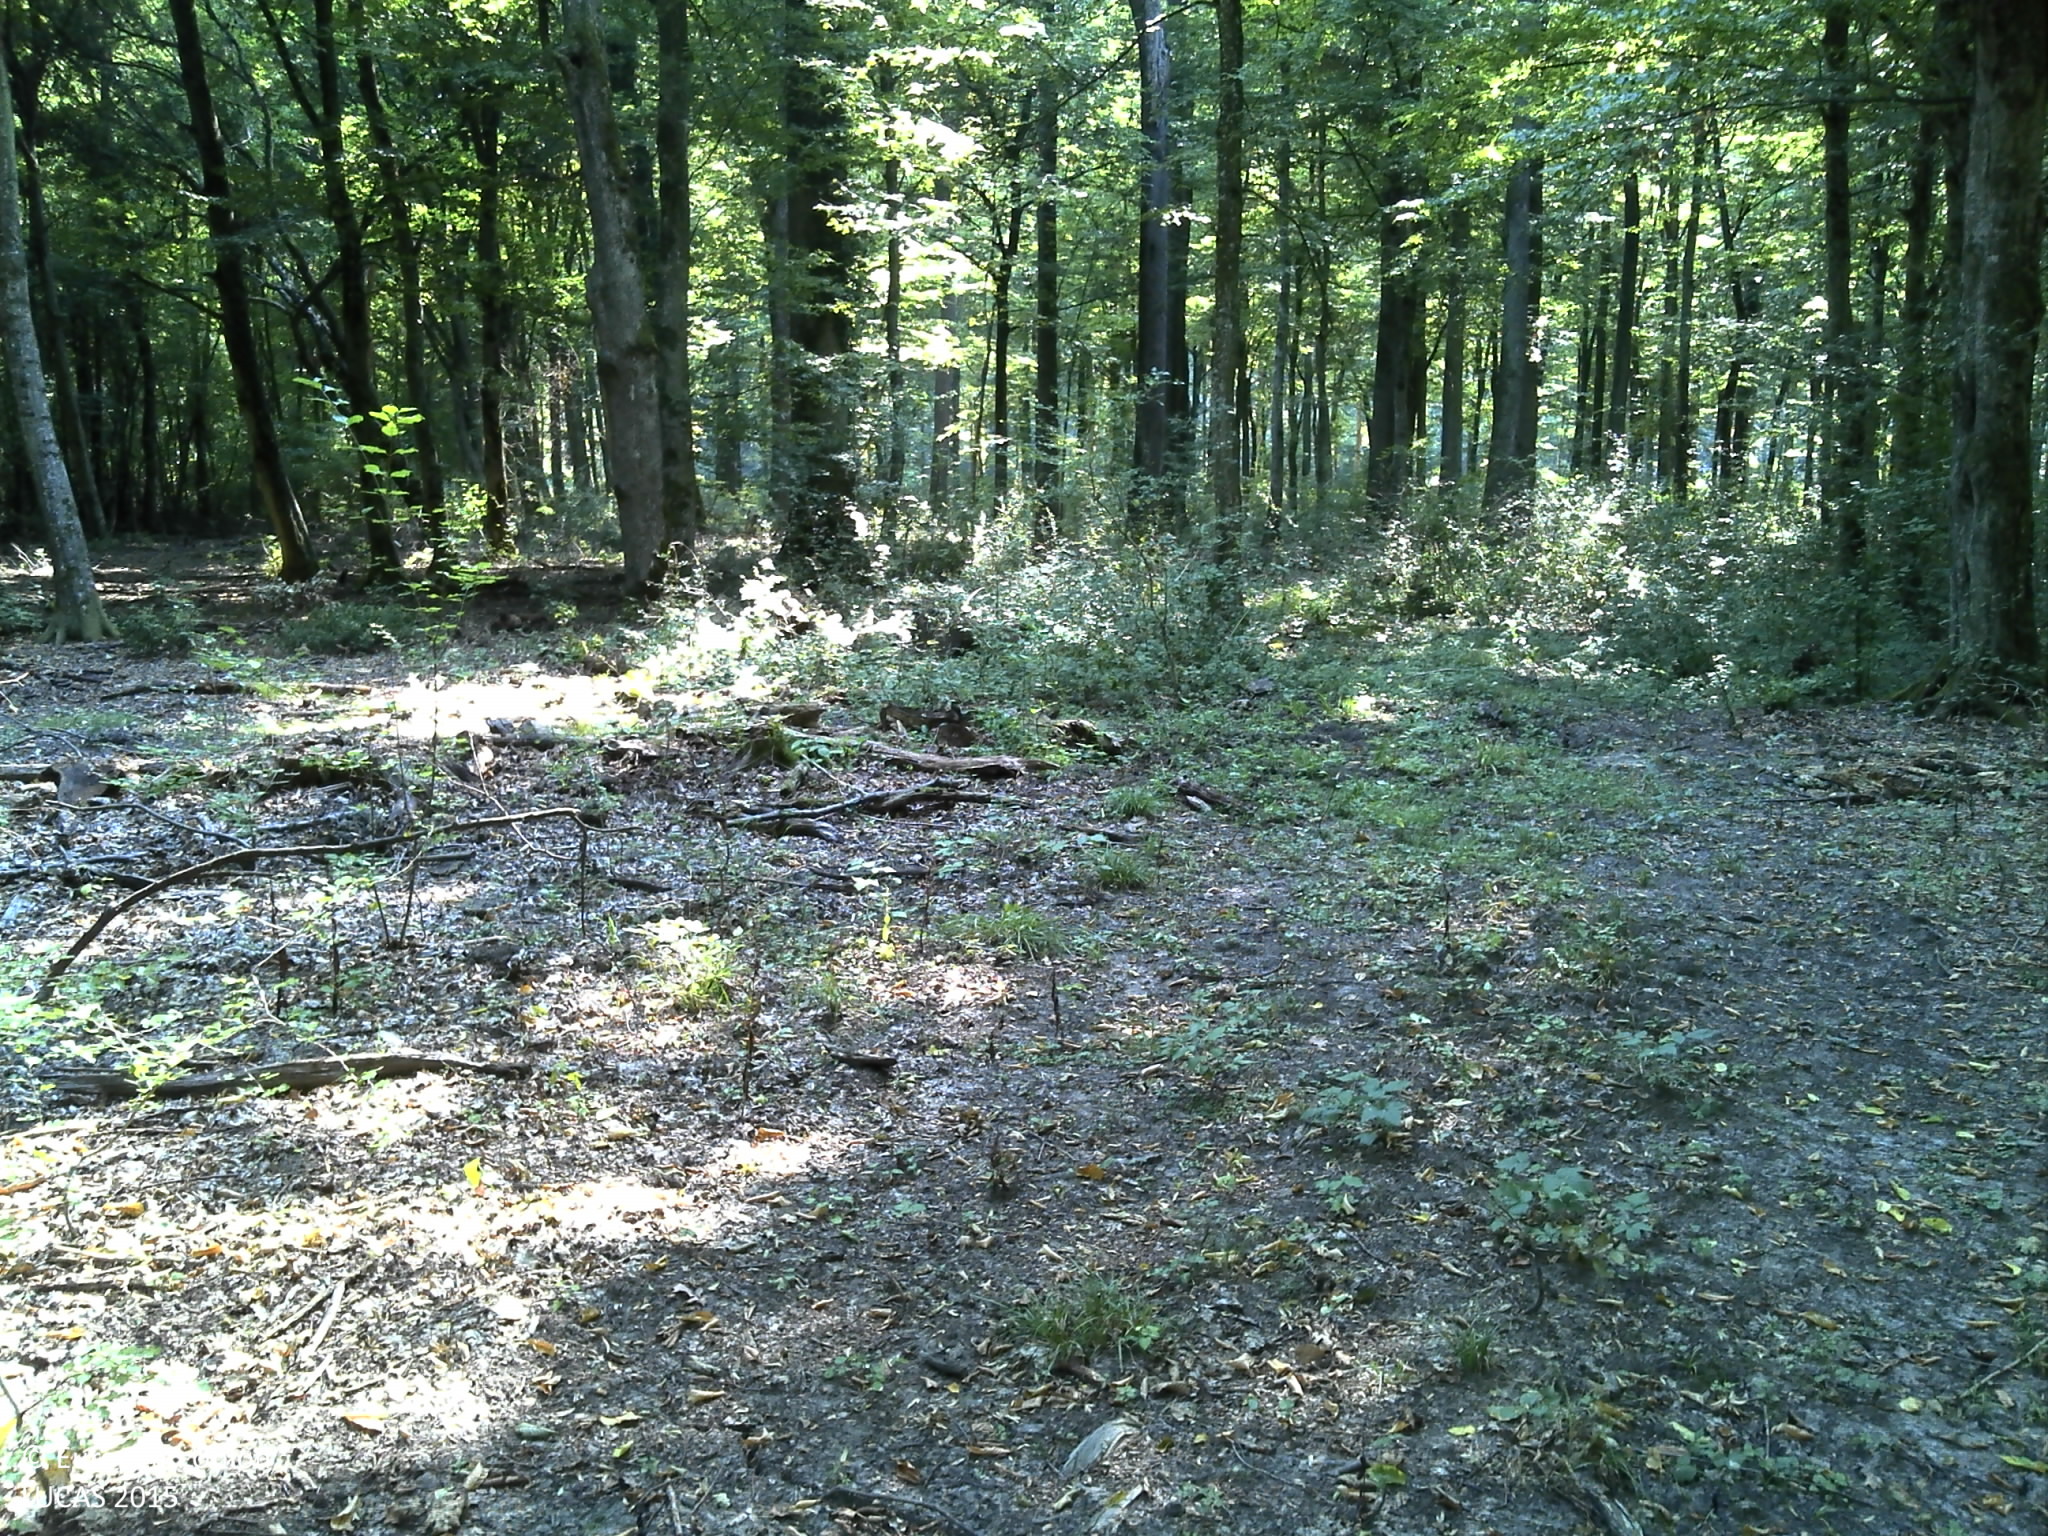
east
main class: Woodland
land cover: Broadleaved woodland
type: acidophilous oak and oak-birch forest
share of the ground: > 75 %
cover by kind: broadleaved forest trees 100 %
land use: Forestry
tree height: > 5 m
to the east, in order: Broadleaved woodland; Ditches and canals; Paved roads, cycling and walking lanes; Ditches and canals; Broadleaved woodland
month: August
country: HR
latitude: 45.1169
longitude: 18.8158
